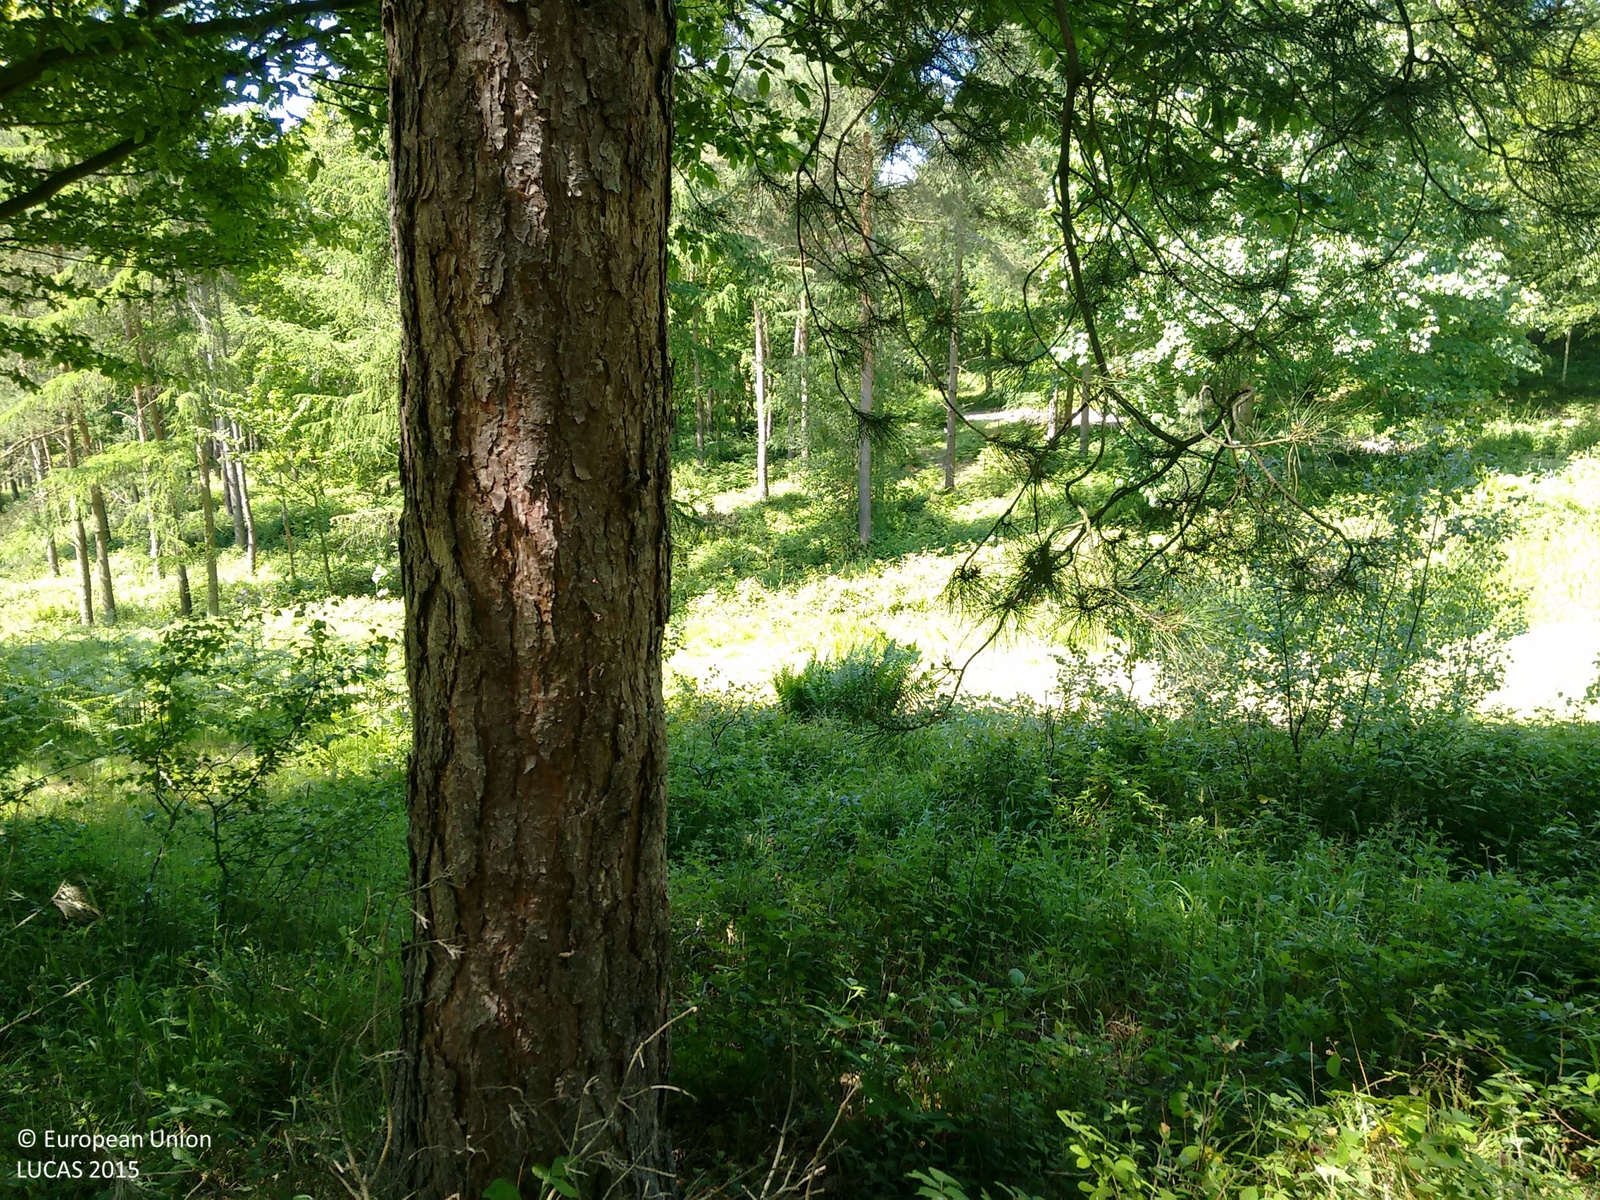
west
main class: Woodland
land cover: Pine dominated coniferous woodland
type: exotic forest
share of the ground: > 75 %
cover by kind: coniferous forest trees 85 %, shrubs 10 %, herbaceous plants 5 %
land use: Forestry
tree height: > 5 m
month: June
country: GB
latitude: 50.9771
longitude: 0.4433
